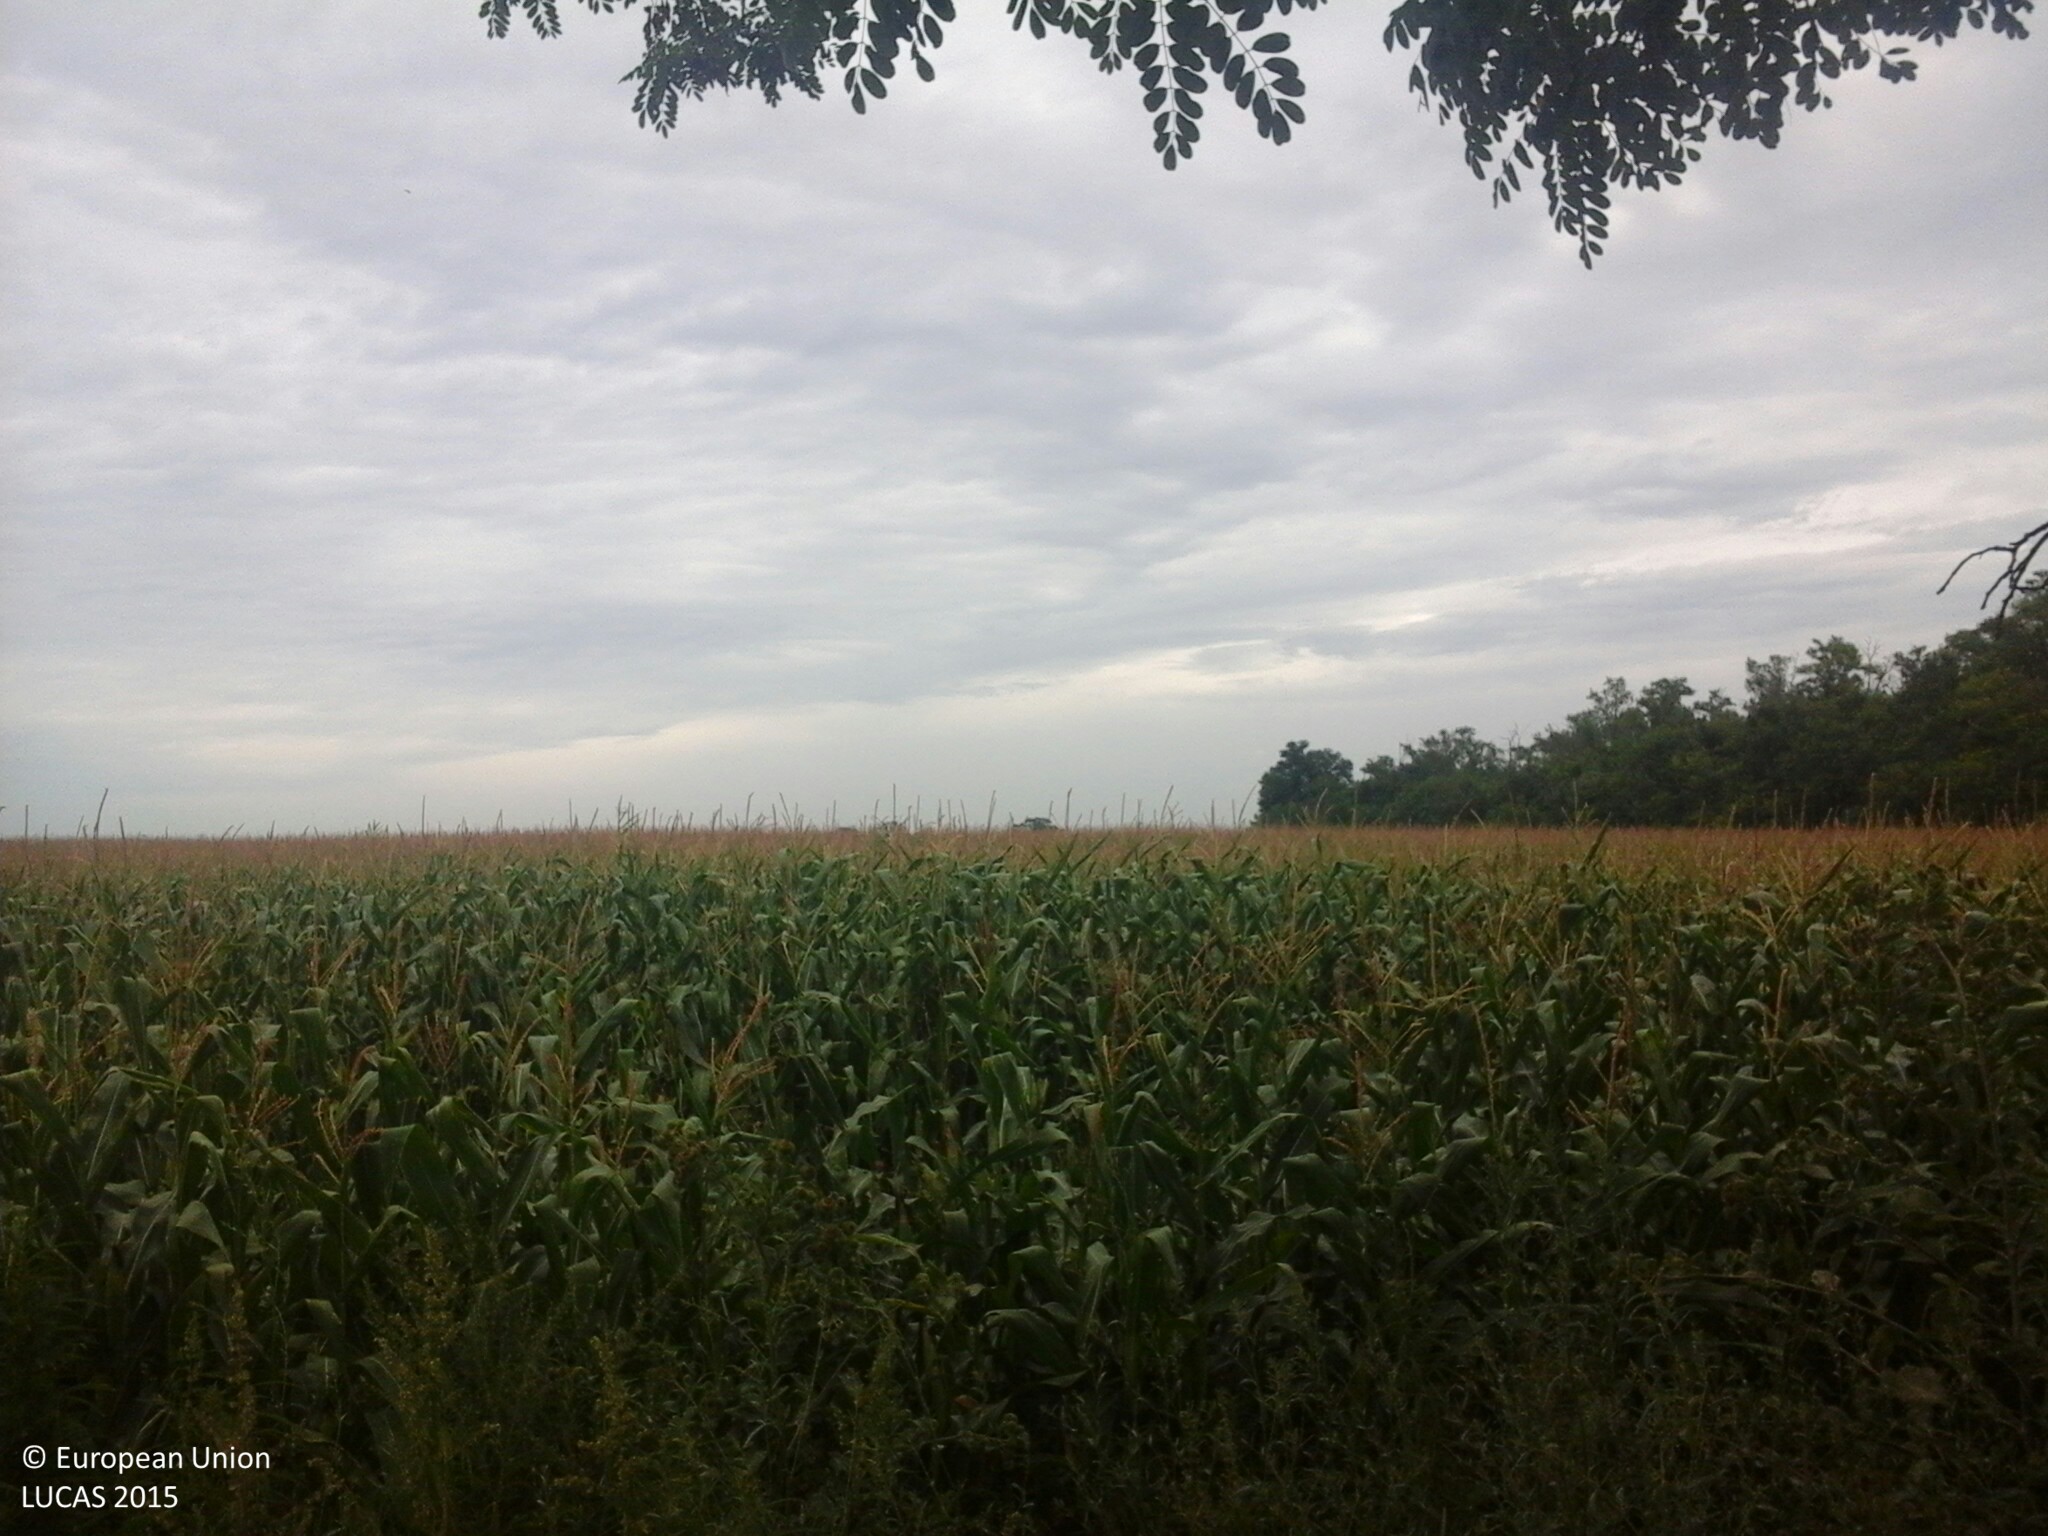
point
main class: Cropland
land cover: Maize
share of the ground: > 75 %
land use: Agriculture (excluding fallow land and kitchen gardens)
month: July
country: HU
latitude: 46.9589
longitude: 18.4350
